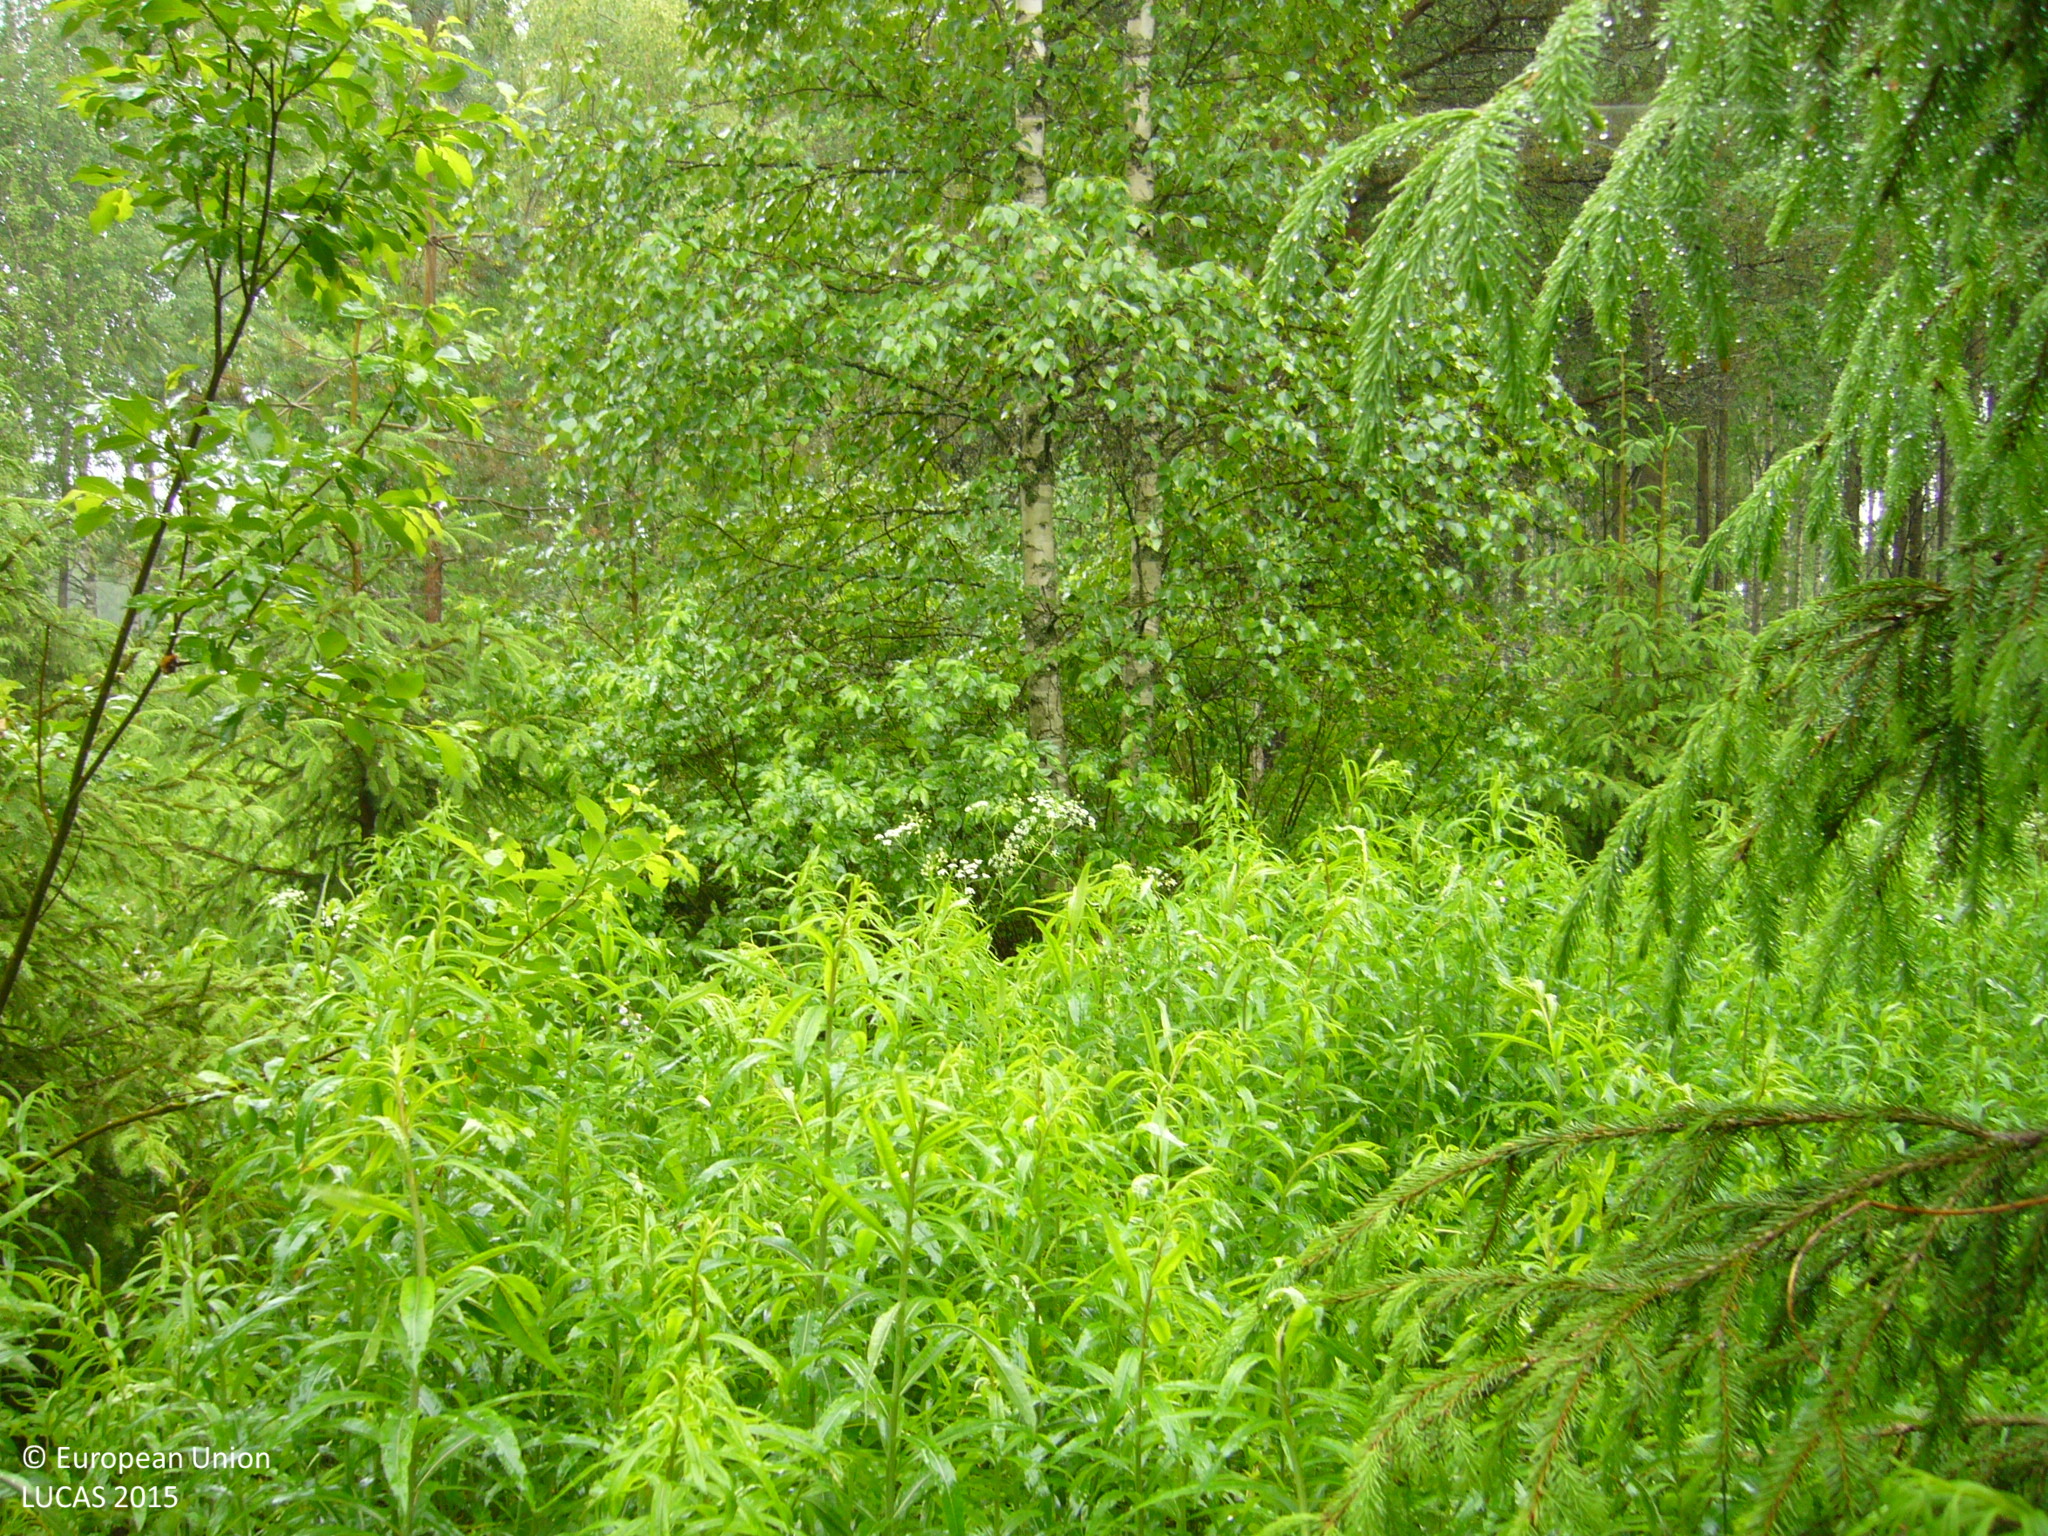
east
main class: Woodland
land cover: Other mixed woodland
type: boreal forest
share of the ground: > 75 %
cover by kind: broadleaved forest trees 50 %, coniferous forest trees 30 %, shrubs 20 %
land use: Forestry
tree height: > 5 m
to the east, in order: Other mixed woodland; Ditches and canals; Other mixed woodland; Electric lines; Other mixed woodland; Ditches and canals; Other mixed woodland; Ditches and canals; Other mixed woodland; Ditches and canals; Other mixed woodland; Ditches and canals; Other mixed woodland; Ditches and canals; Other mixed woodland; Ditches and canals; Other mixed woodland; Ditches and canals; Other mixed woodland; Ditches and canals; Other mixed woodland; Ditches and canals; Other mixed woodland
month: June
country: FI
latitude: 63.6610
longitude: 26.0935
